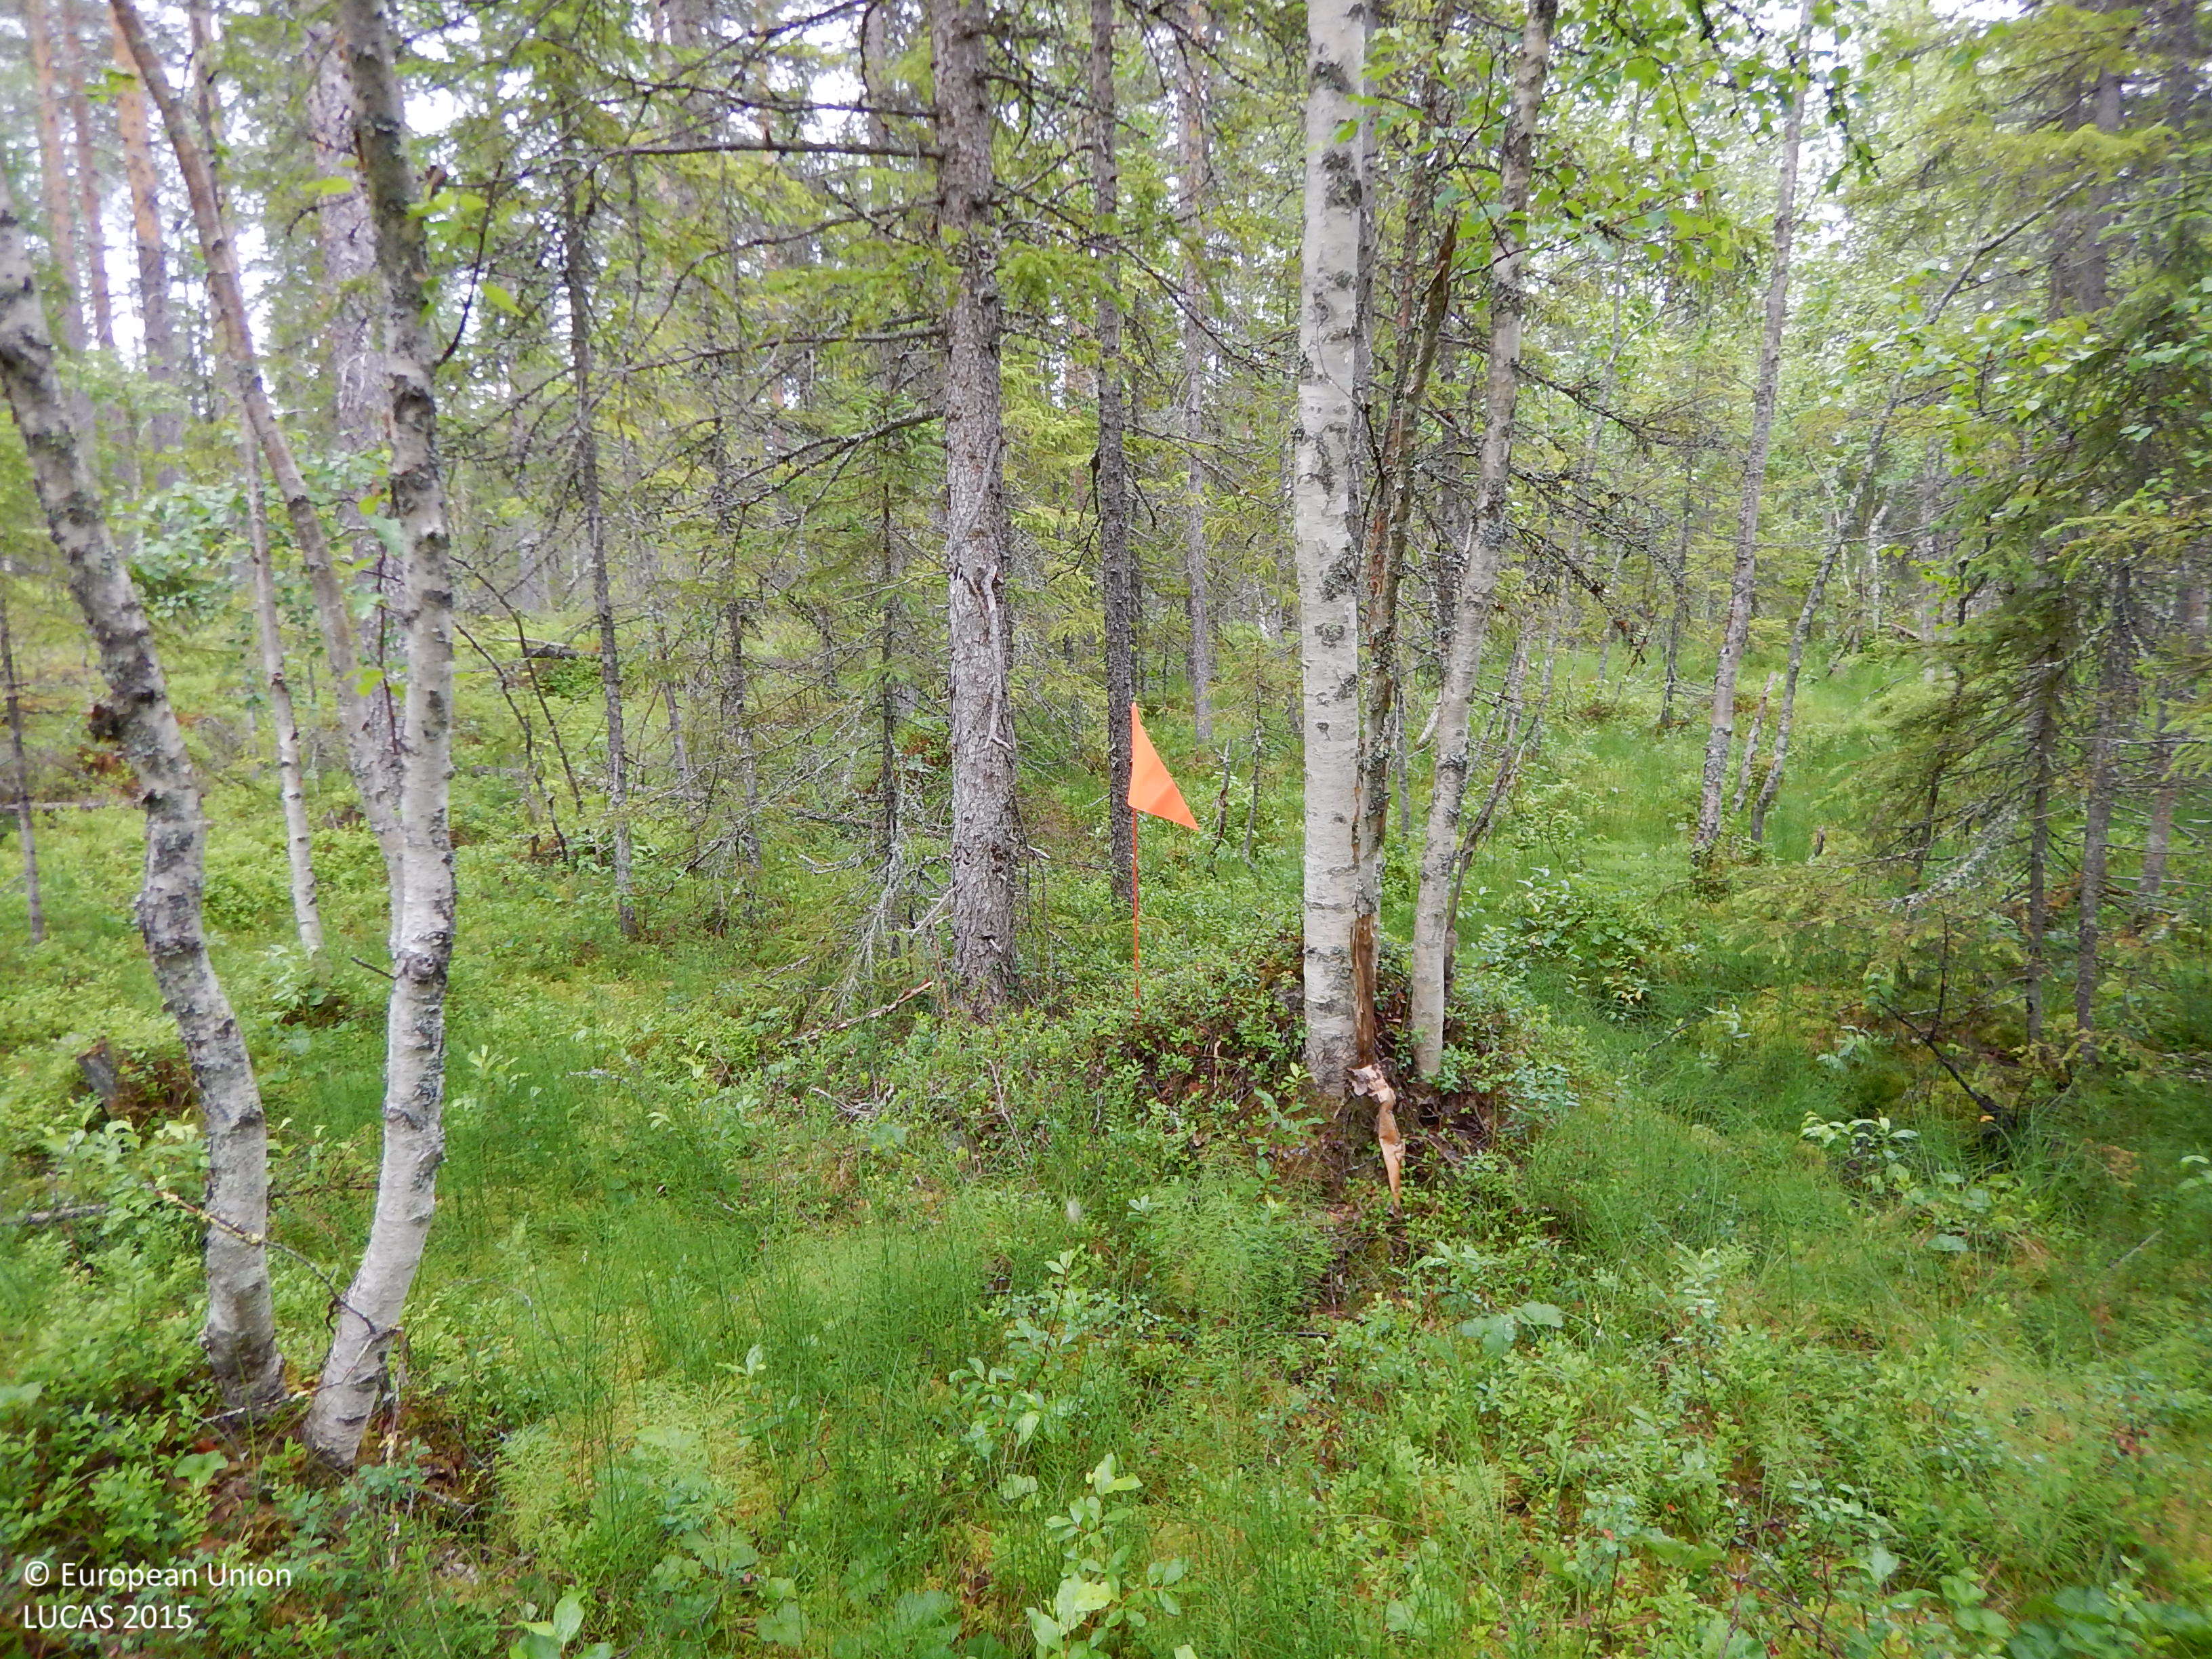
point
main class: Woodland
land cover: Spruce dominated coniferous woodland
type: mire and swamp forests
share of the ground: 50 - 75 %
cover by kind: coniferous forest trees 40 %, lichens and mosses 25 %, shrubs 15 %, broadleaved forest trees 10 %, herbaceous plants 10 %
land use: Forestry
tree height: > 5 m
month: July
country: SE
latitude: 64.6903
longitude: 20.1830
